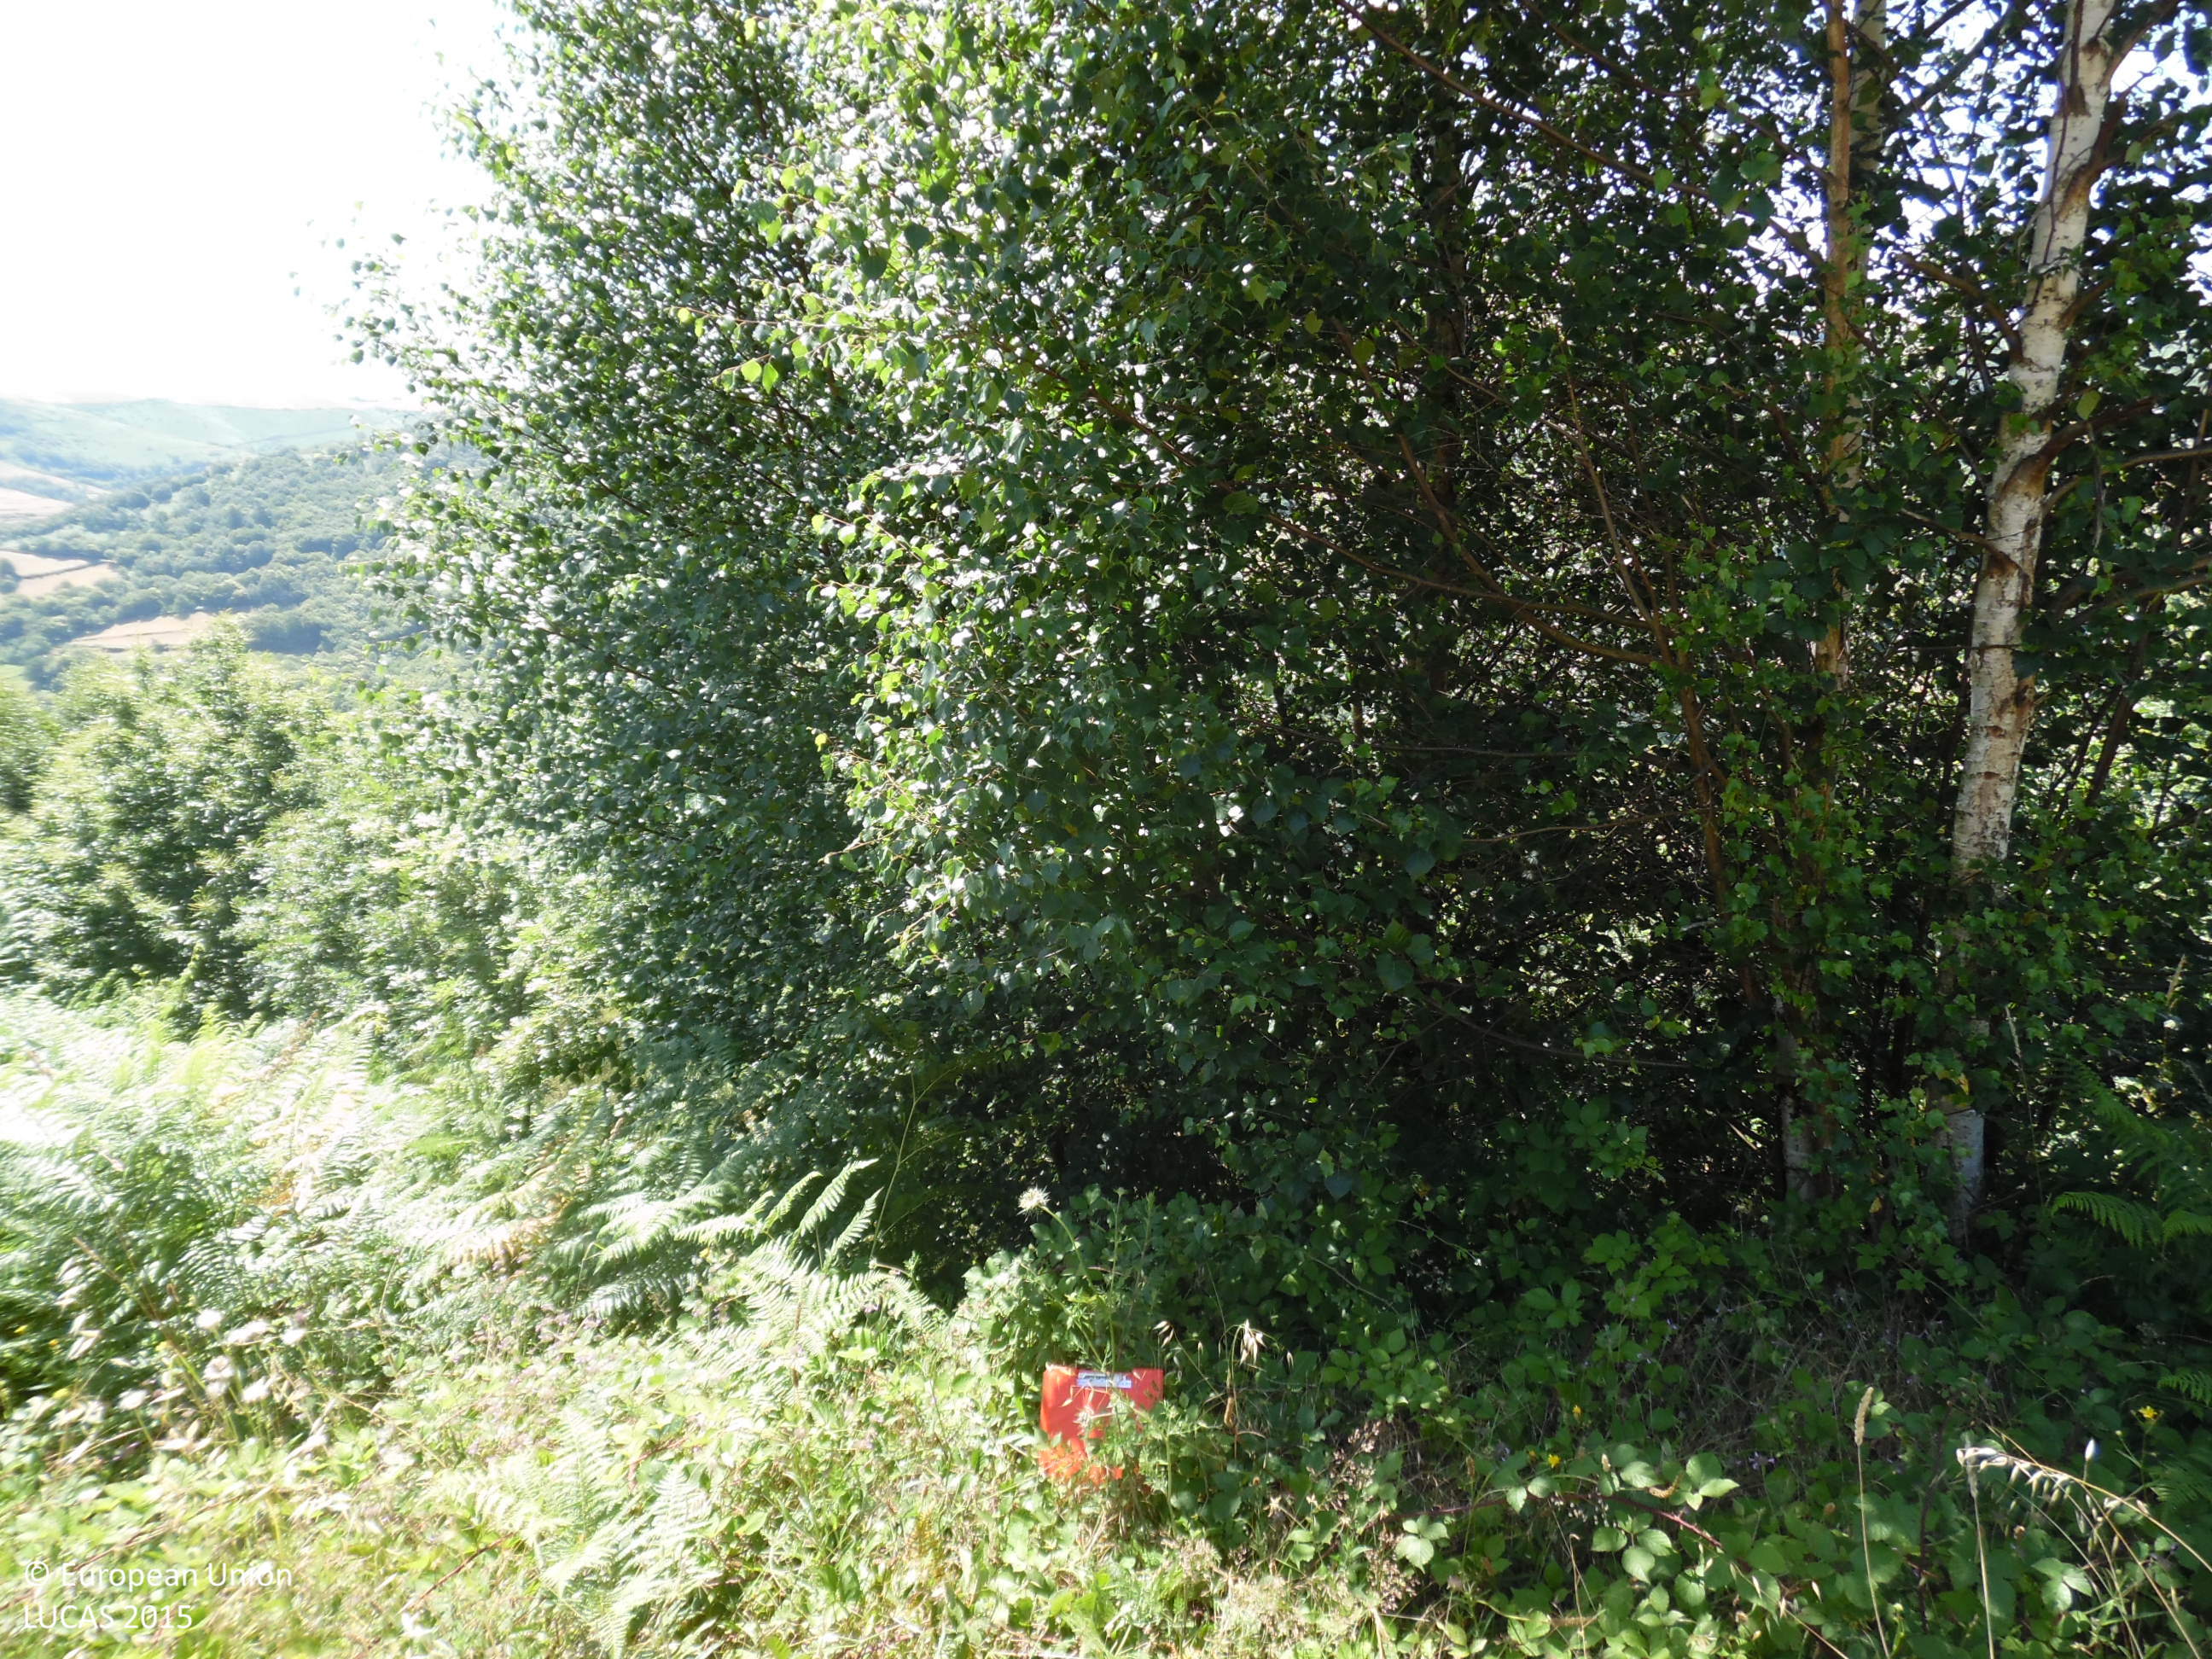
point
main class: Shrubland
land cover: Shrubland with sparse tree cover
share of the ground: 50 - 75 %
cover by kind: shrubs 80 %, consolidated bare surface 15 %, broadleaved forest trees 5 %
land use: Forestry
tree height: < 5 m
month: July
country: ES
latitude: 43.2031
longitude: -6.6079
